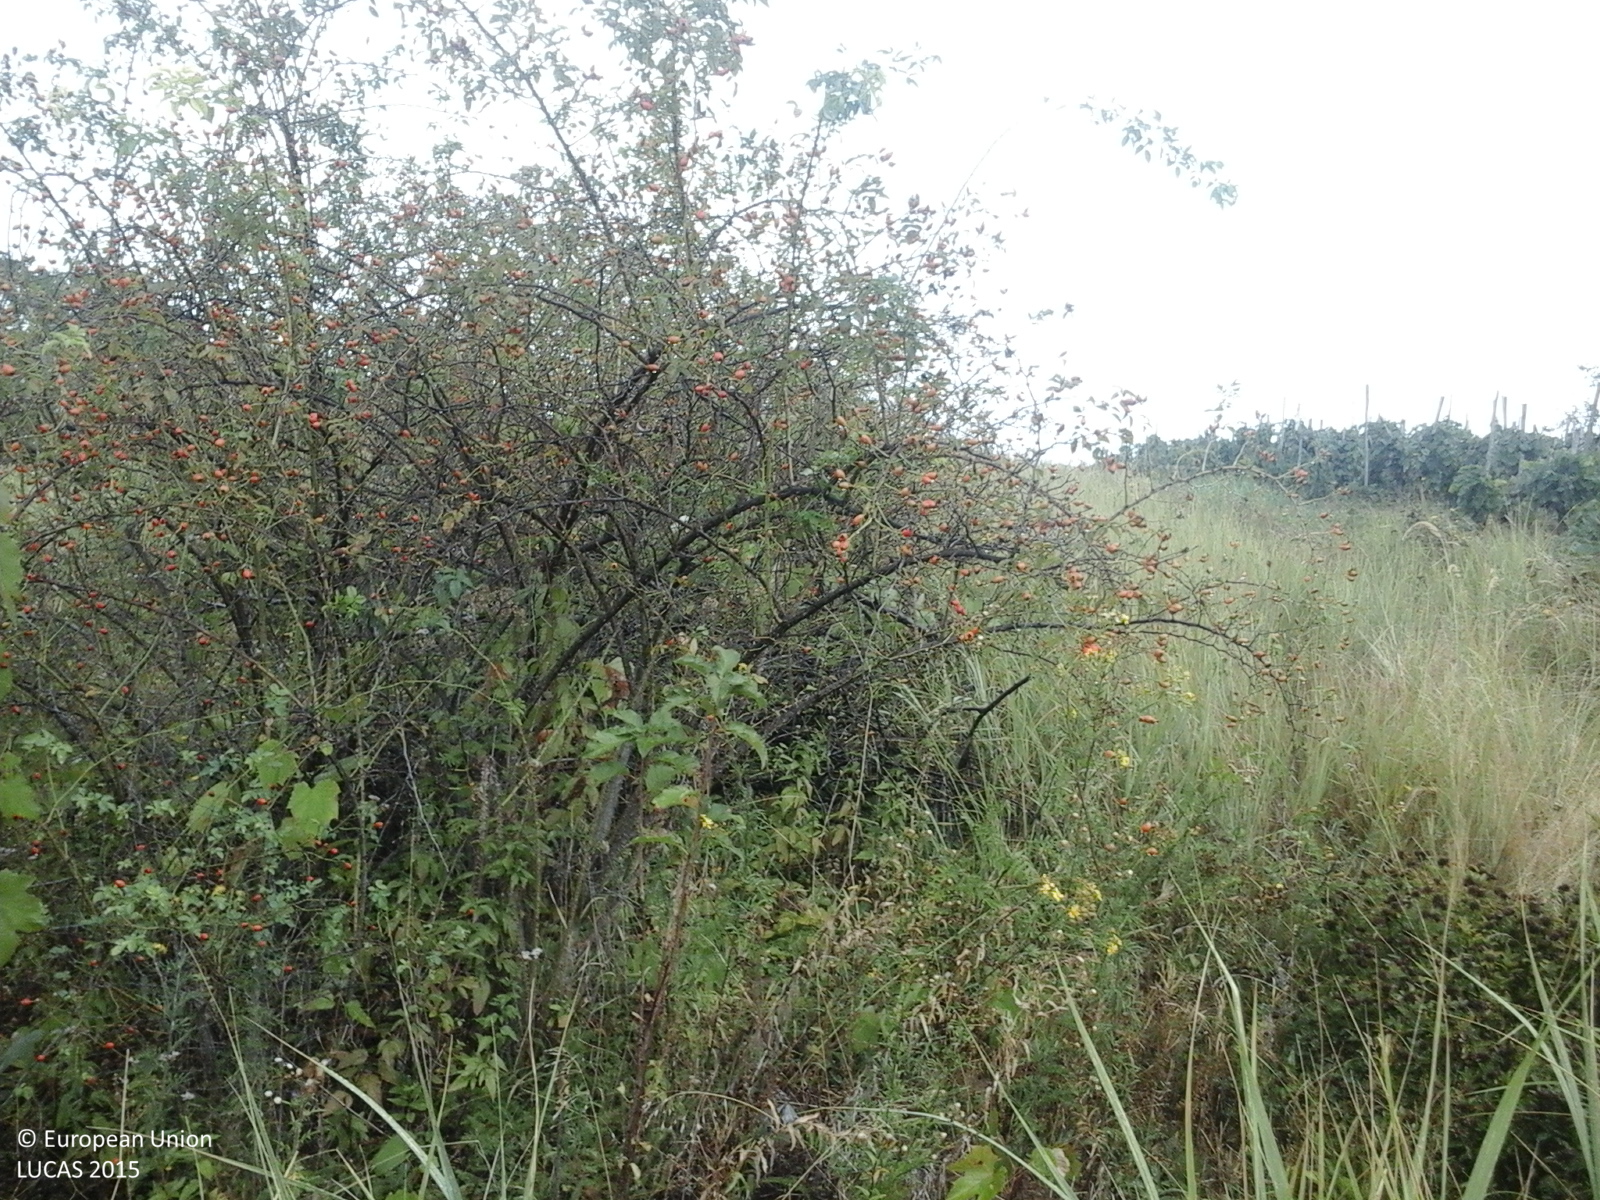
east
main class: Grassland
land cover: Grassland with sparse tree/shrub cover
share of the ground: > 75 %
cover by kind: herbaceous plants 85 %, shrubs 10 %, broadleaved forest trees 5 %
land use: Fallow land
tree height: < 5 m
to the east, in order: Grassland with sparse tree/shrub cover; Grassland without tree/shrub cover; Vineyards; Grass margins; Tracks; Grass margins; Lucerne; Grassland with sparse tree/shrub cover
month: September
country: RO
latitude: 47.3698
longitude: 22.5986
